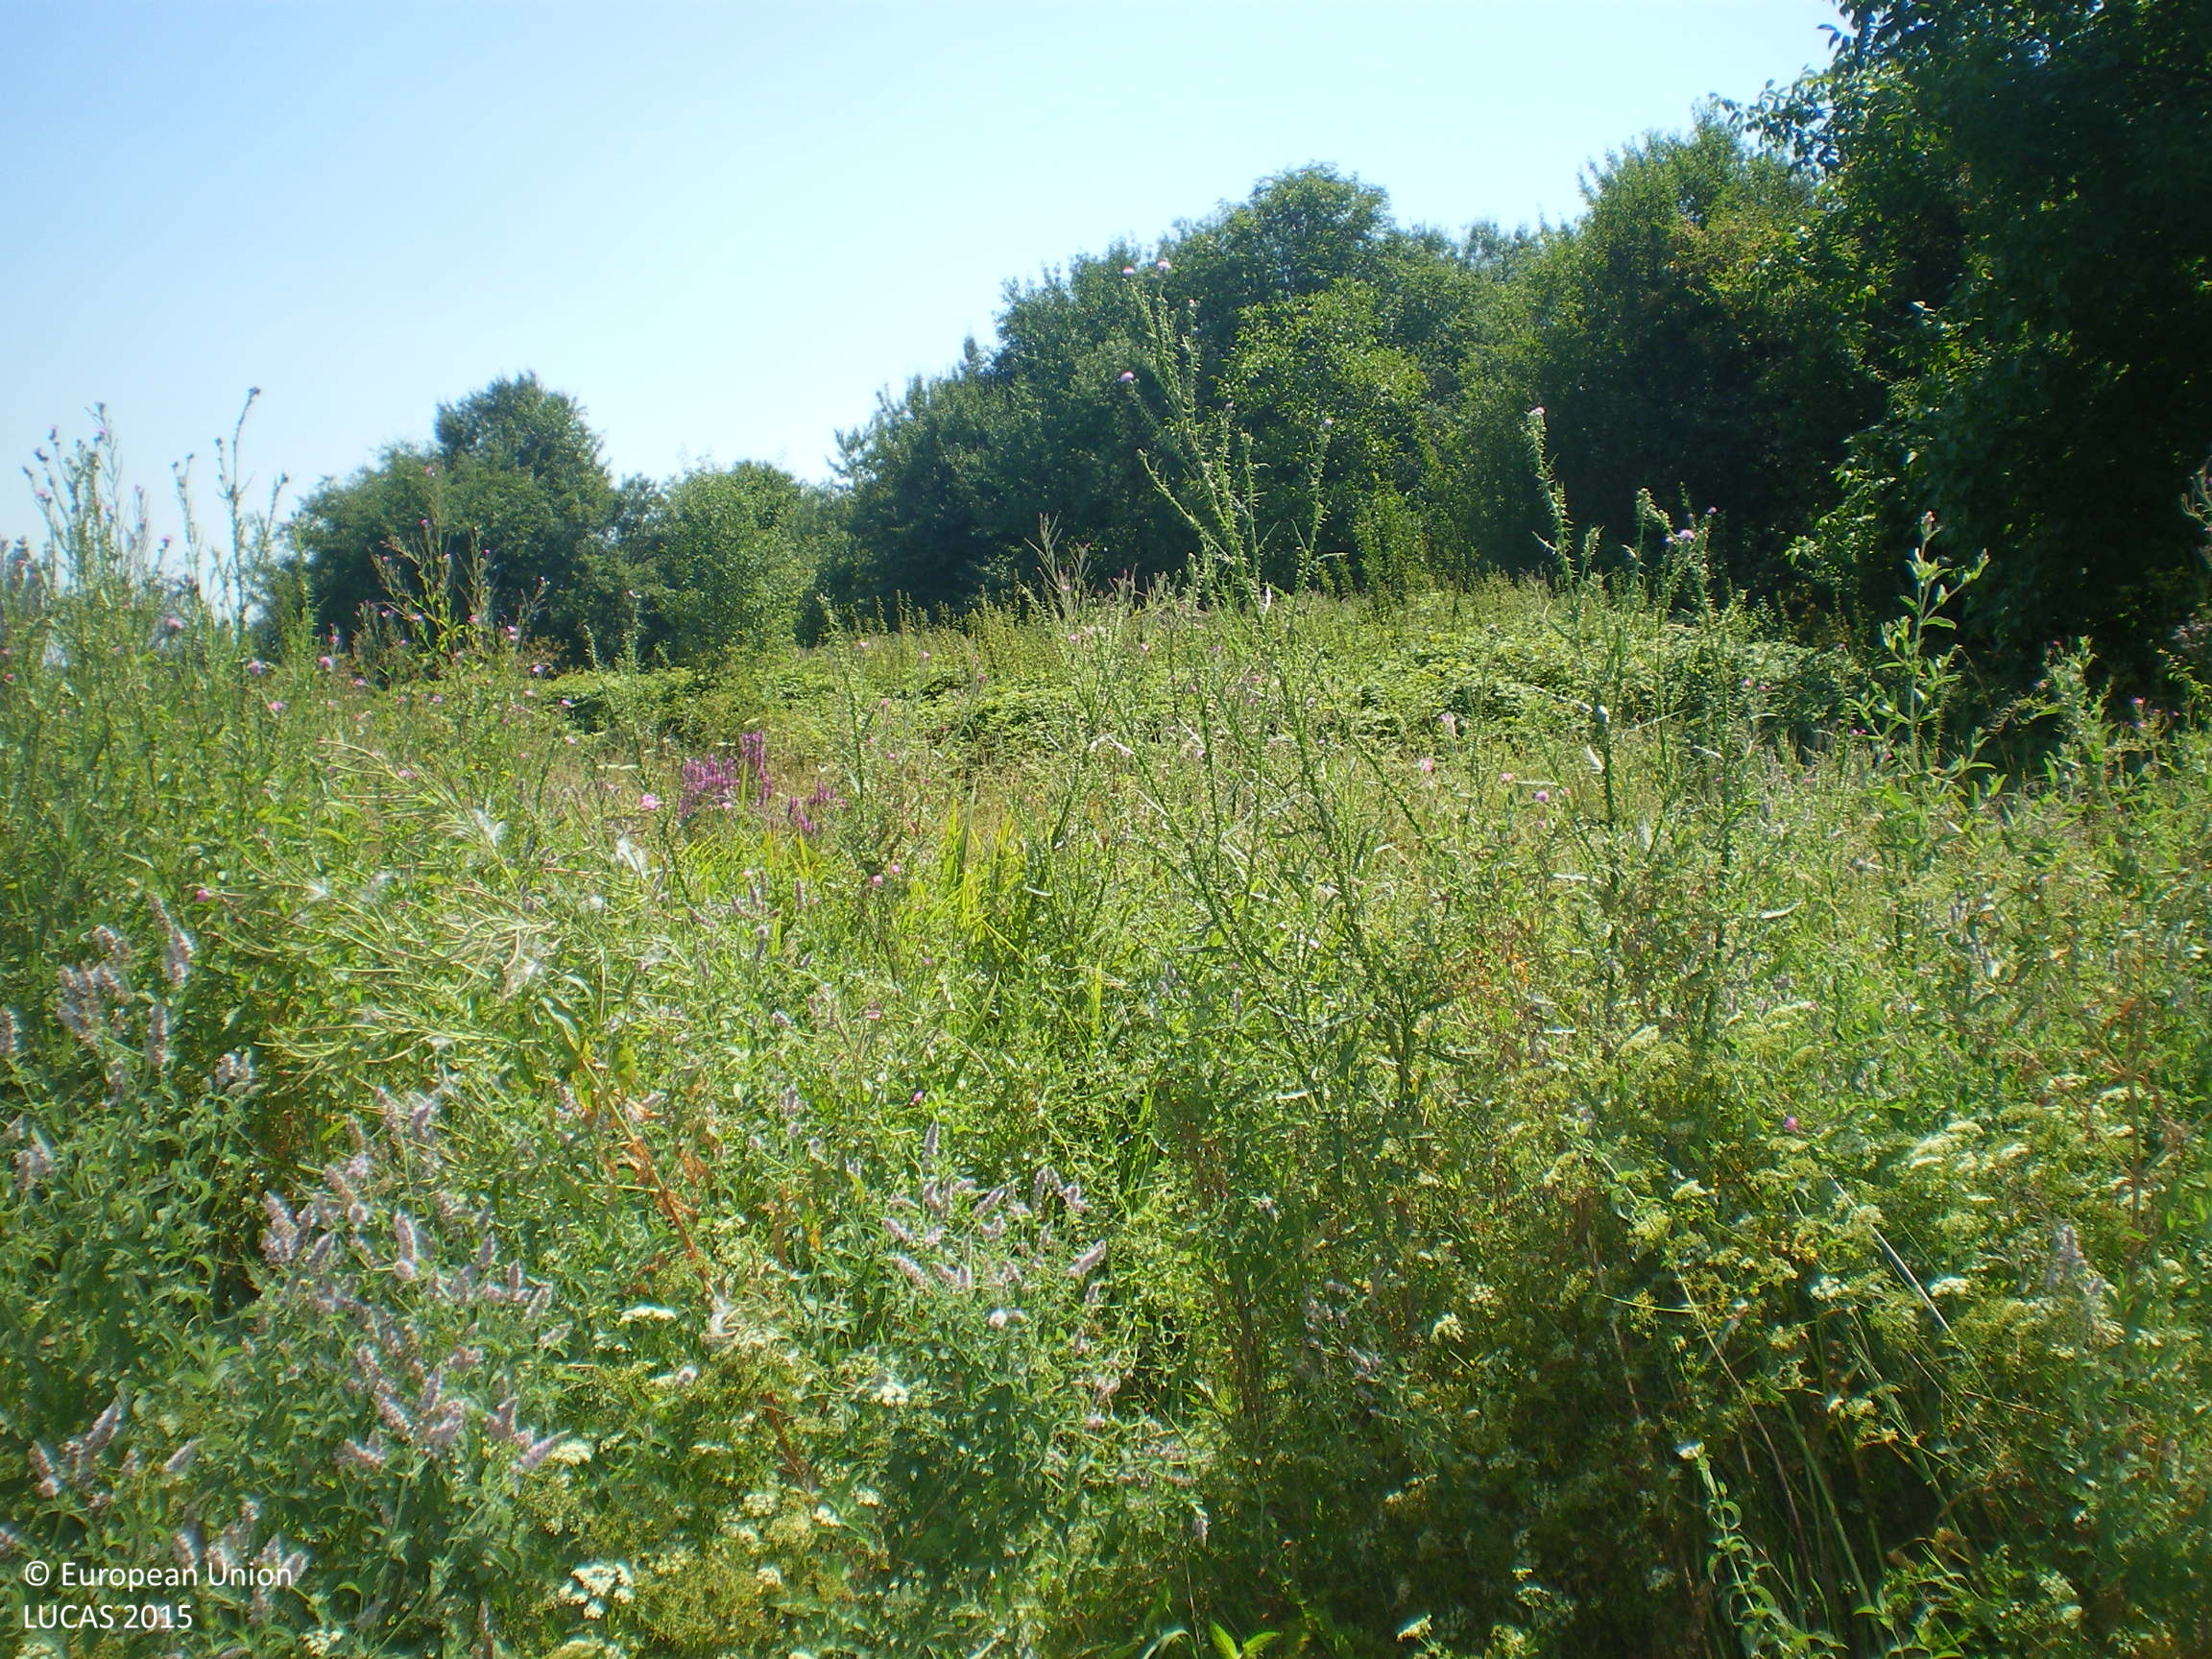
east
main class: Grassland
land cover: Spontaneously vegetated surfaces
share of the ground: > 75 %
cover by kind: herbaceous plants 100 %
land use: Semi-natural and natural areas not in use
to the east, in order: Spontaneously vegetated surfaces; Inland marshes; Grassland with sparse tree/shrub cover; Shrubland with sparse tree cover; Broadleaved woodland; Grassland with sparse tree/shrub cover; Tracks; Common wheat
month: July
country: BG
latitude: 42.5943
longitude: 25.1143
